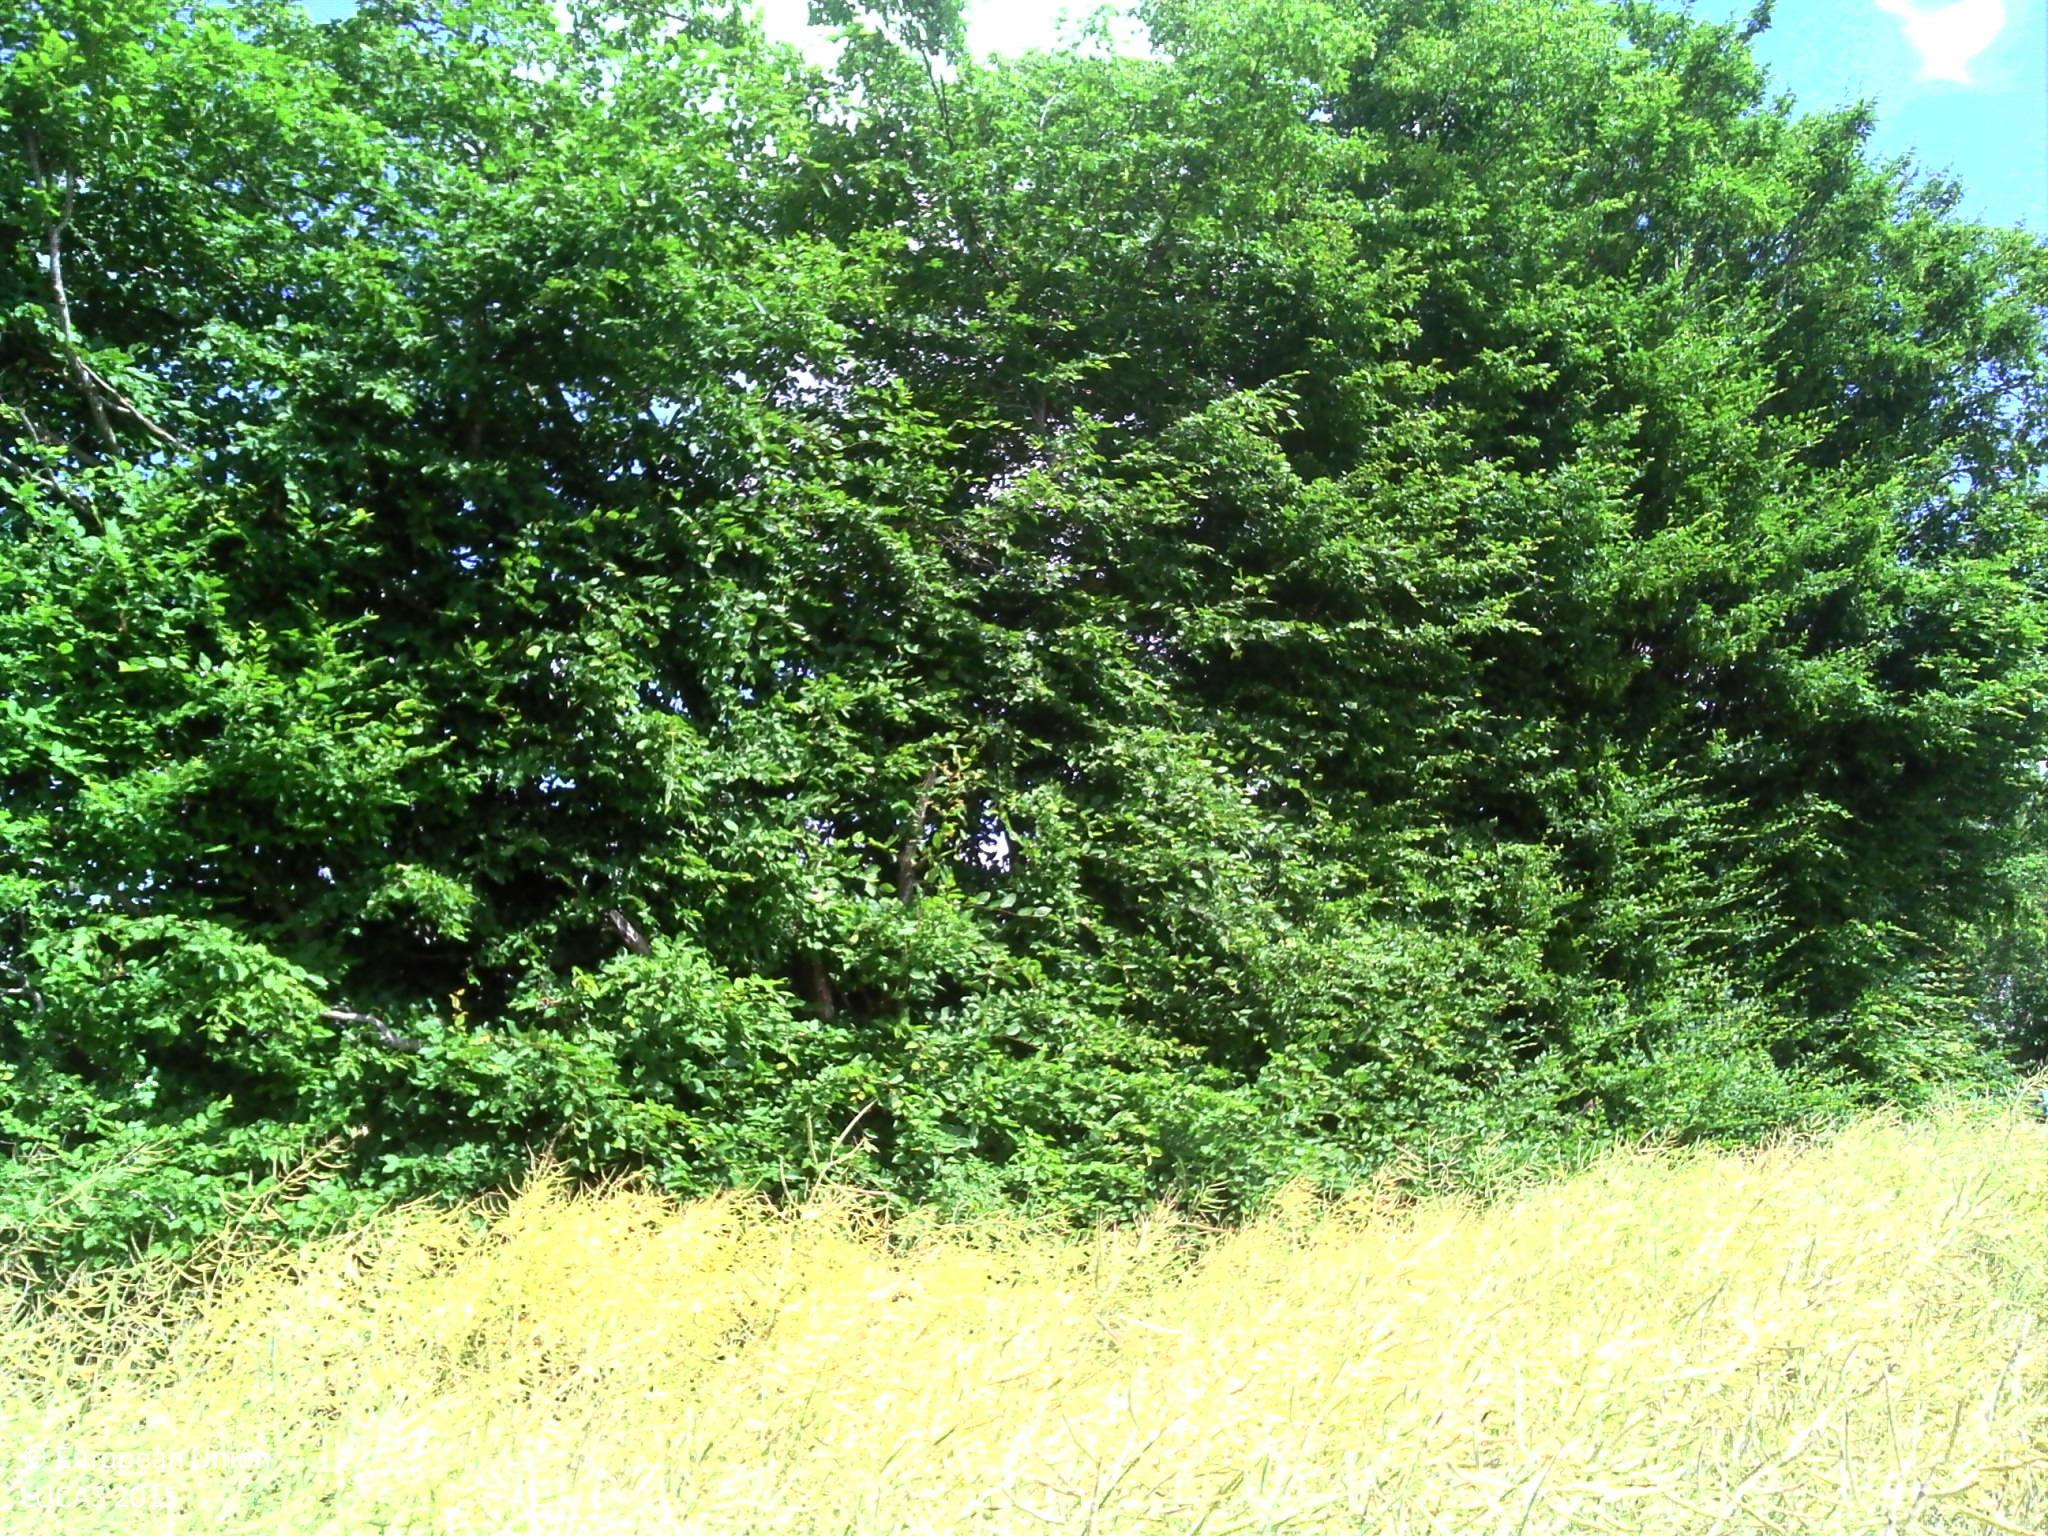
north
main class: Cropland
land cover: Rape and turnip rape
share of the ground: > 75 %
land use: Agriculture (excluding fallow land and kitchen gardens)
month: June
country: FR
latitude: 47.4492
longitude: 2.5788
